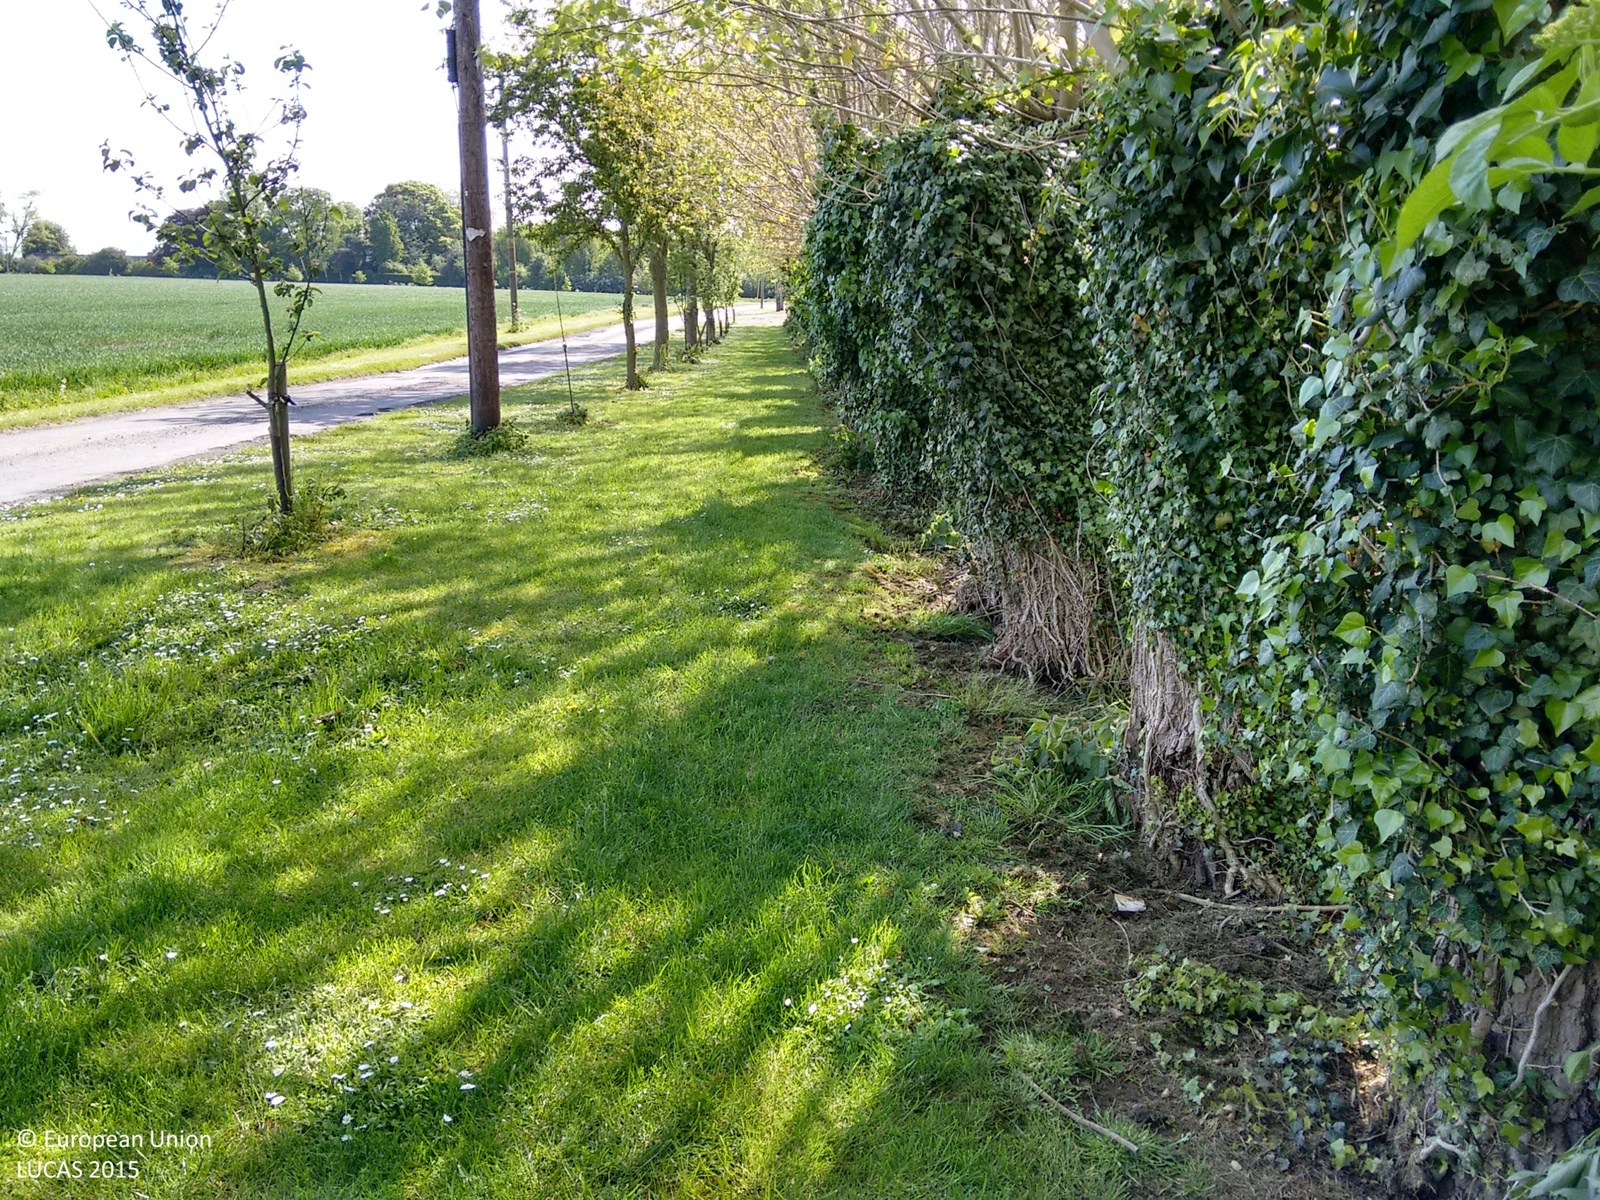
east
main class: Grassland
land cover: Grassland without tree/shrub cover
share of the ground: > 75 %
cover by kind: herbaceous plants 80 %, unconsolidated bare surface 20 %
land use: Logistics and storage
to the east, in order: Grassland without tree/shrub cover; Artificial constructions in urban areas; Grass margins; Ditches and canals; Broadleaved woodland; Grassland without tree/shrub cover; Inland fresh running water
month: May
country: GB
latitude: 52.7843
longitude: -0.0408
